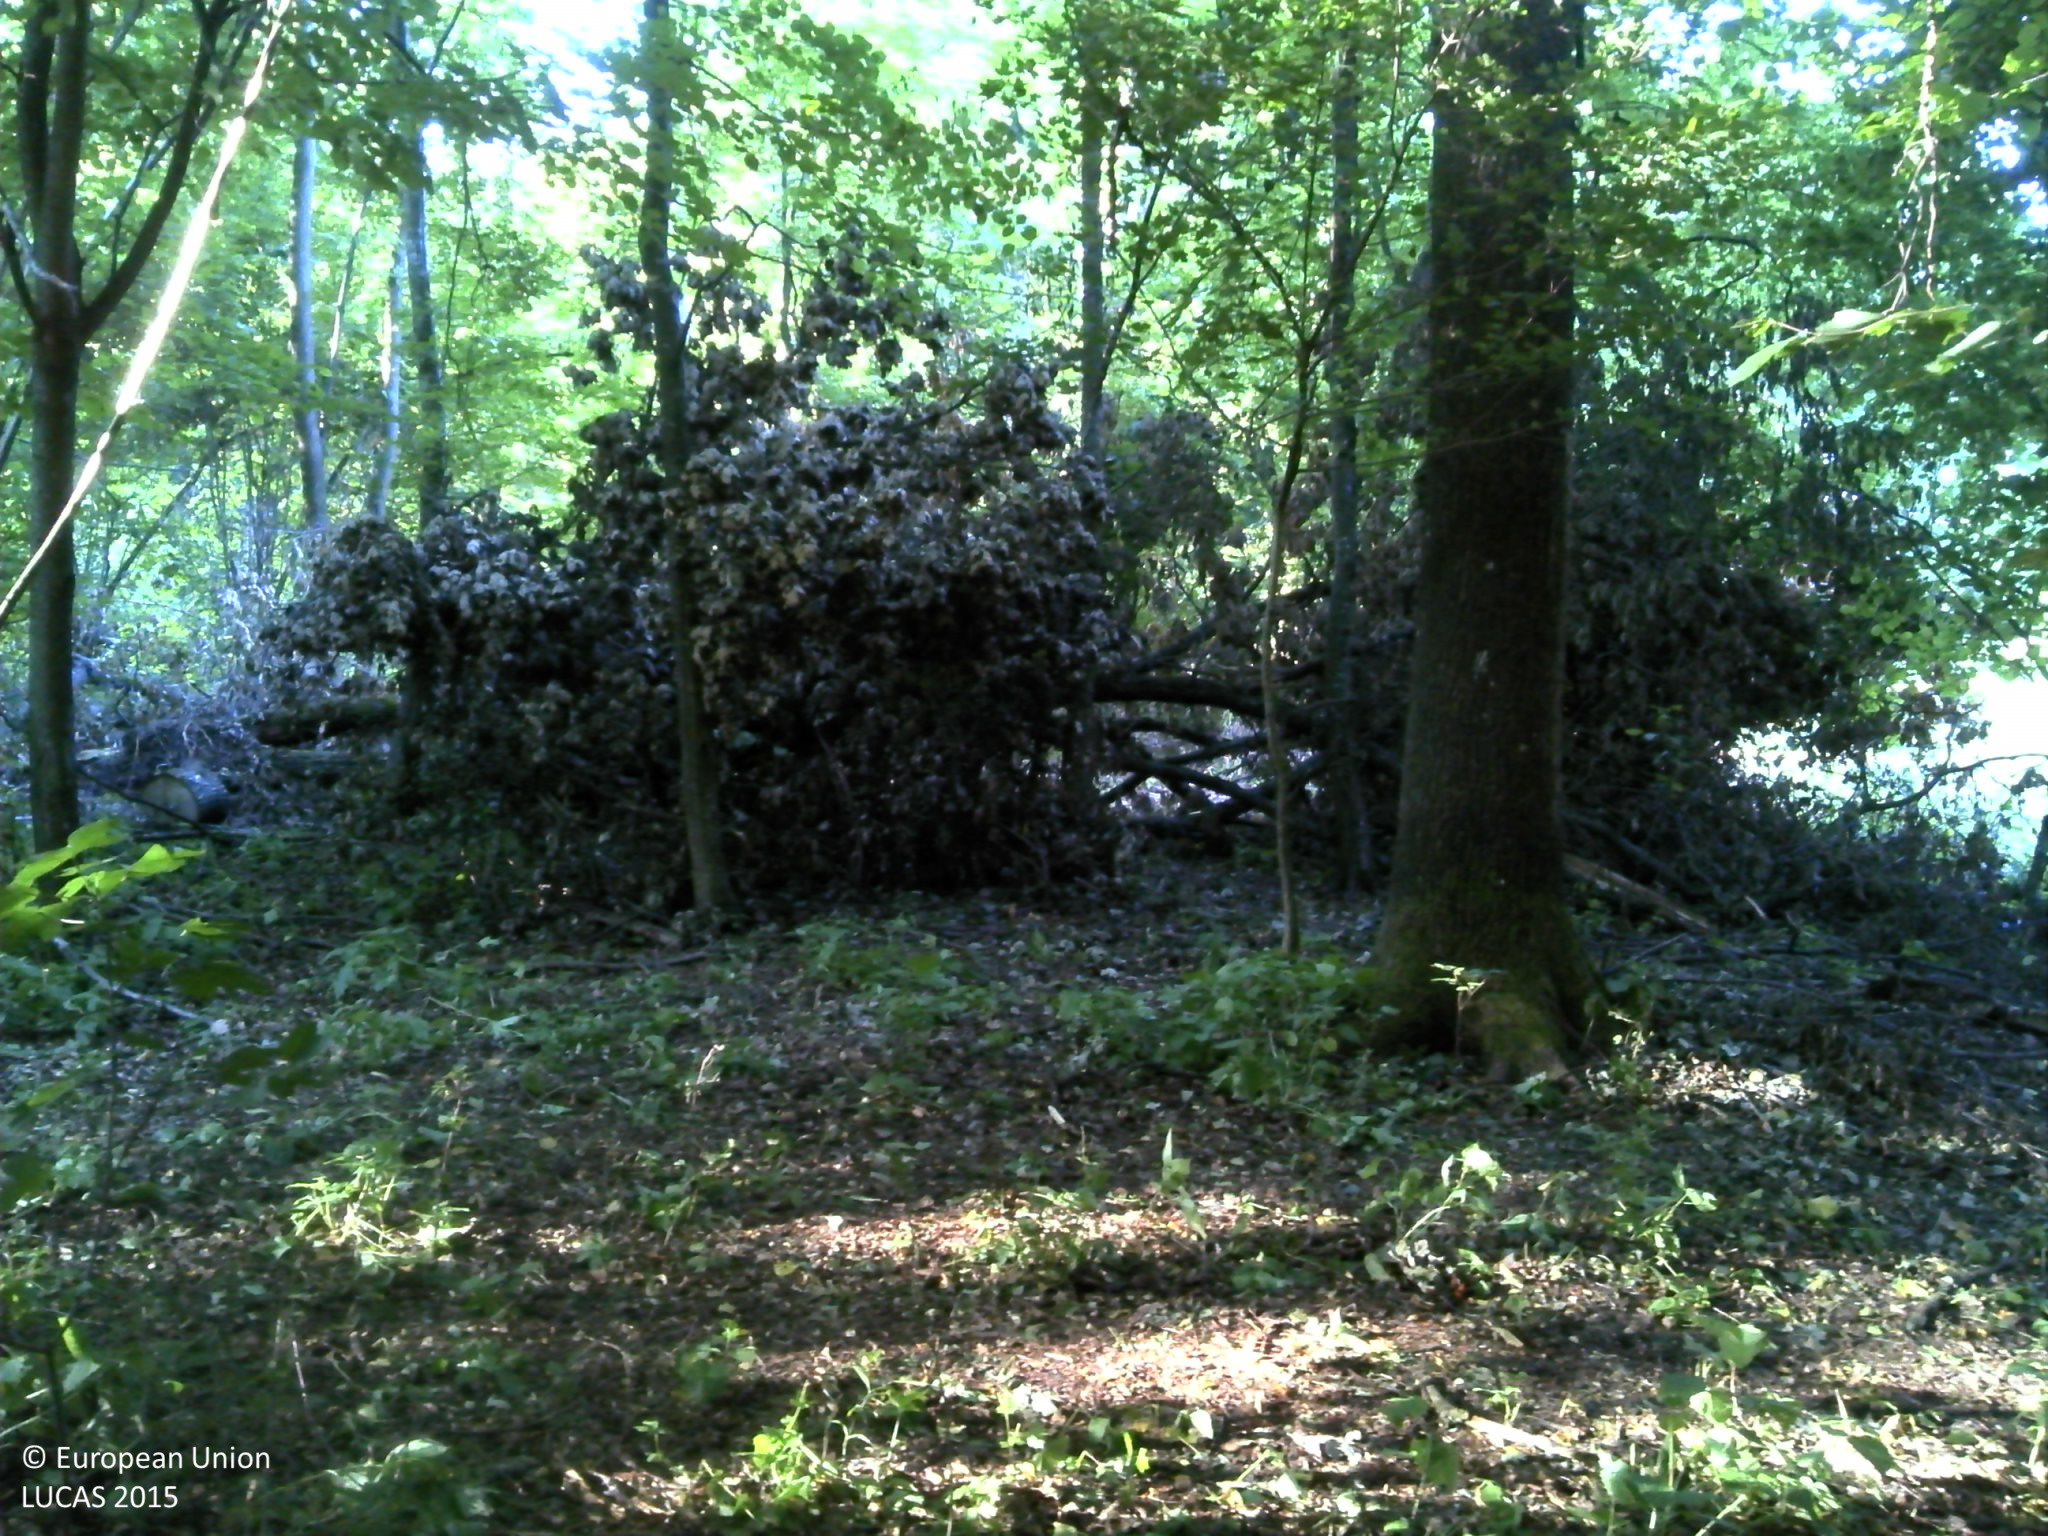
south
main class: Woodland
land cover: Broadleaved woodland
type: acidophilous oak and oak-birch forest
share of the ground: > 75 %
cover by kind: broadleaved forest trees 90 %, shrubs 5 %, herbaceous plants 5 %
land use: Forestry
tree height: > 5 m
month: July
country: HR
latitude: 45.9915
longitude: 16.7785
